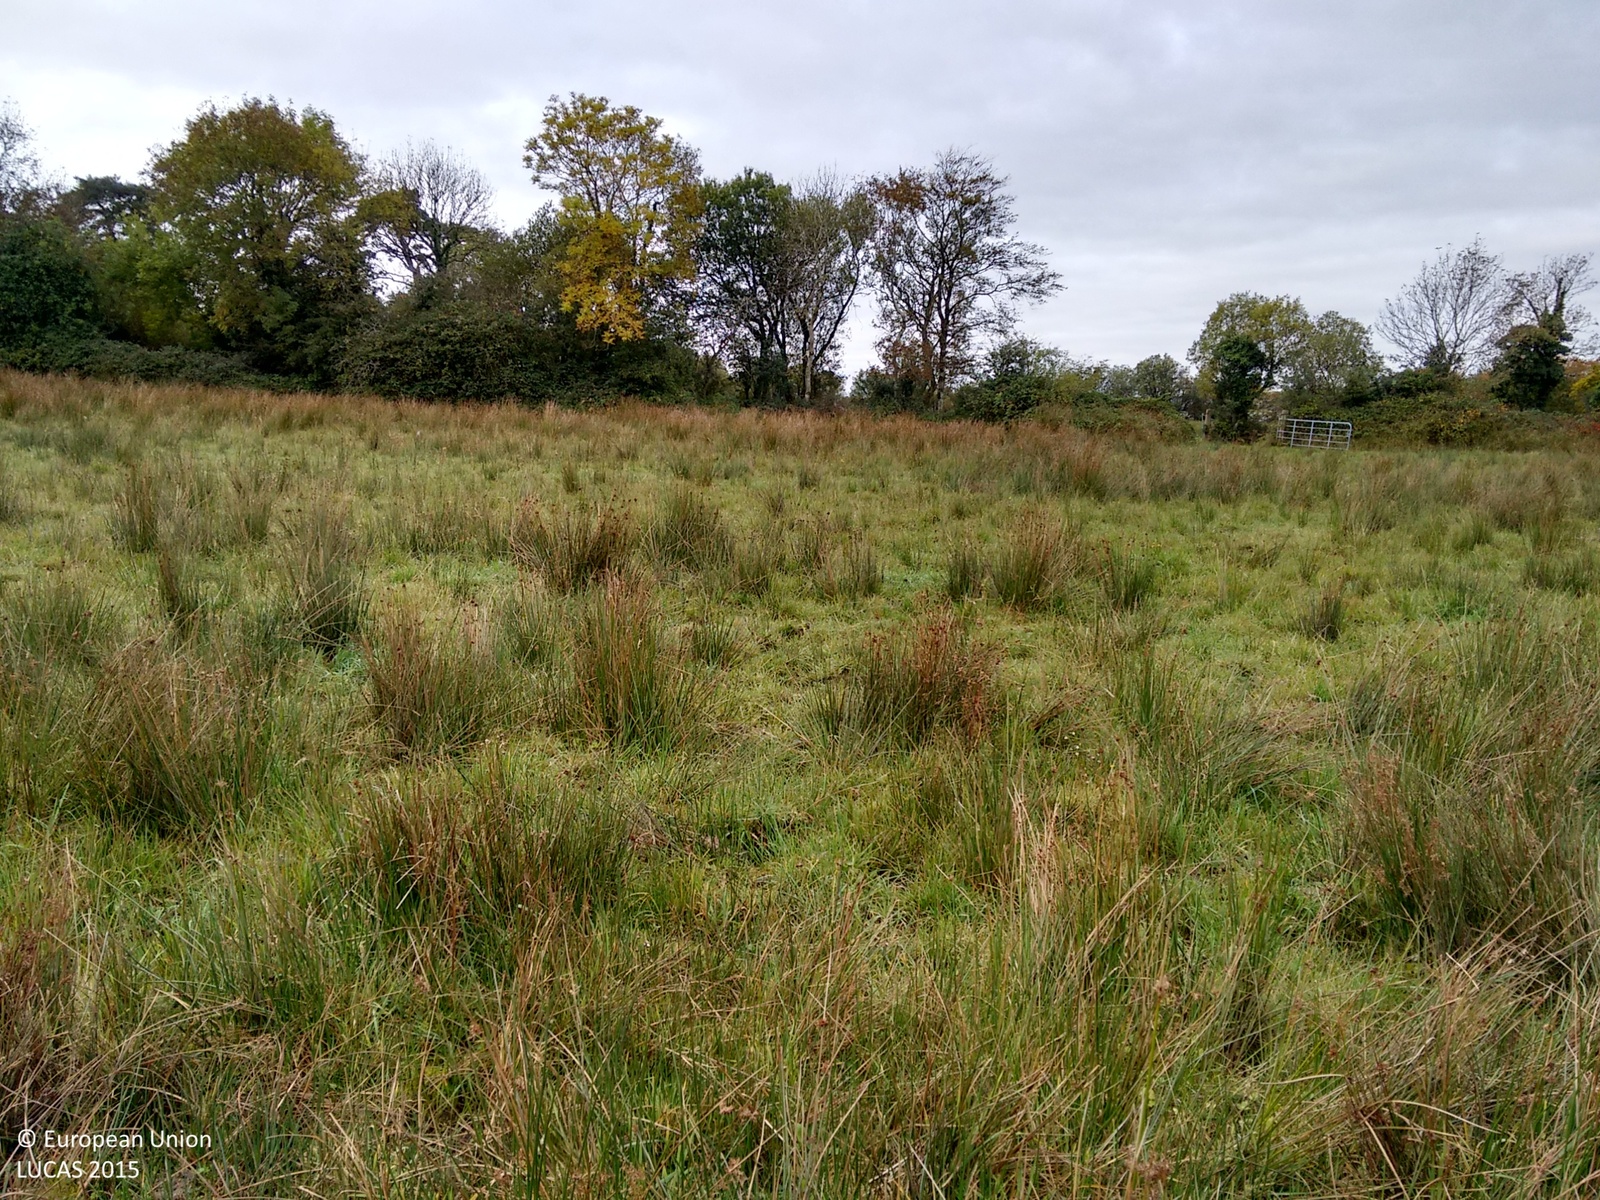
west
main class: Grassland
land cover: Grassland without tree/shrub cover
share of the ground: > 75 %
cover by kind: herbaceous plants 100 %
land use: Agriculture (excluding fallow land and kitchen gardens)
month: October
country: GB
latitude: 54.5132
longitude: -7.8539
